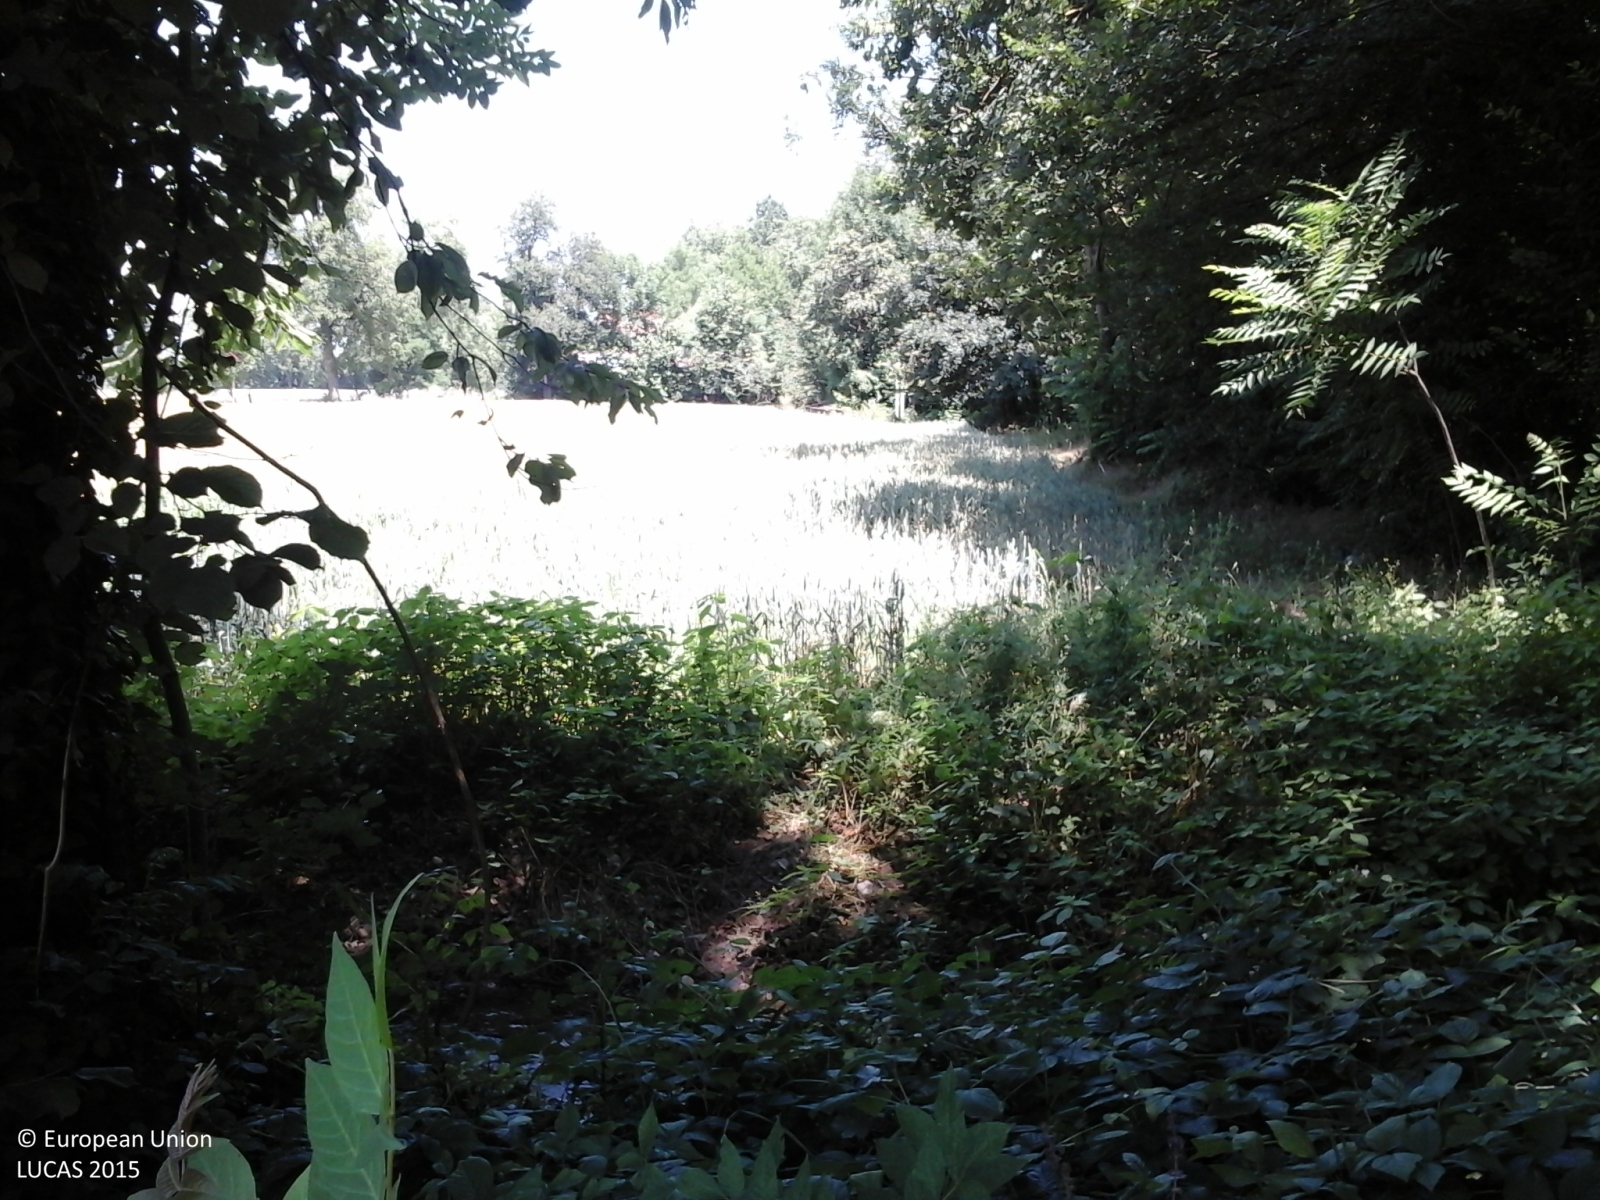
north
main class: Woodland
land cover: Broadleaved woodland
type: thermophilous deciduous forest
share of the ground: > 75 %
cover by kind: broadleaved forest trees 80 %, shrubs 15 %, herbaceous plants 5 %
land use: Semi-natural and natural areas not in use
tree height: > 5 m
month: June
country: IT
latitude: 44.3794
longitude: 7.7080
